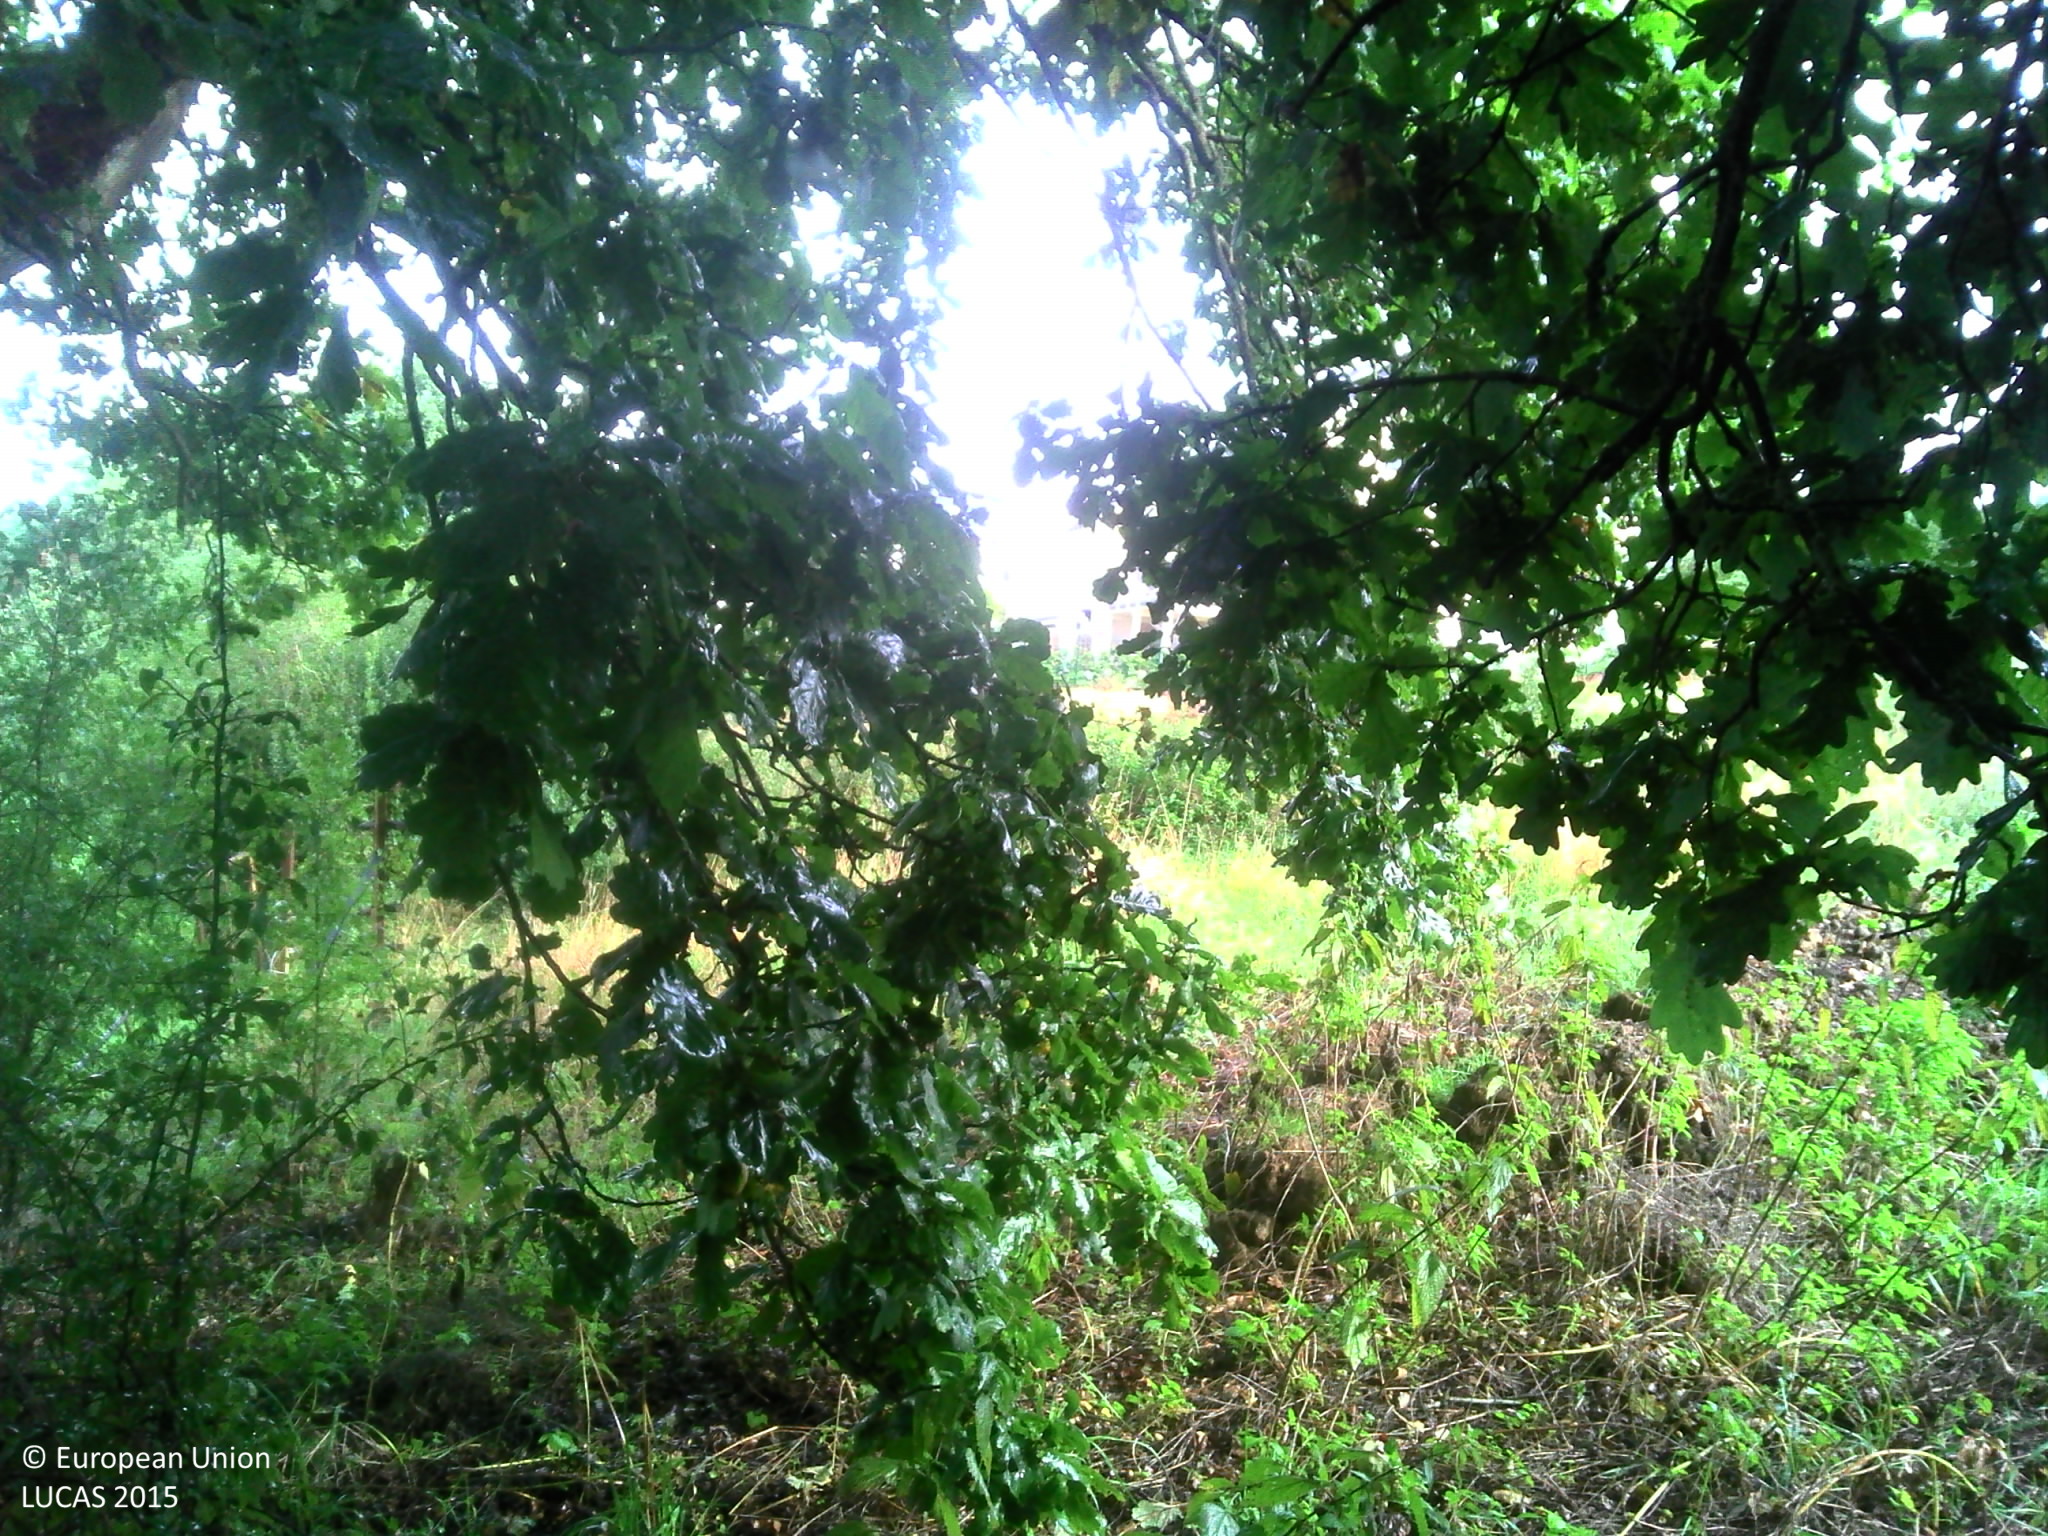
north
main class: Woodland
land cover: Broadleaved woodland
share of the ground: > 75 %
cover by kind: broadleaved forest trees 70 %, herbaceous plants 20 %, unconsolidated bare surface 10 %
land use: Residential
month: September
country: LU
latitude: 49.7725
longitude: 6.0141
